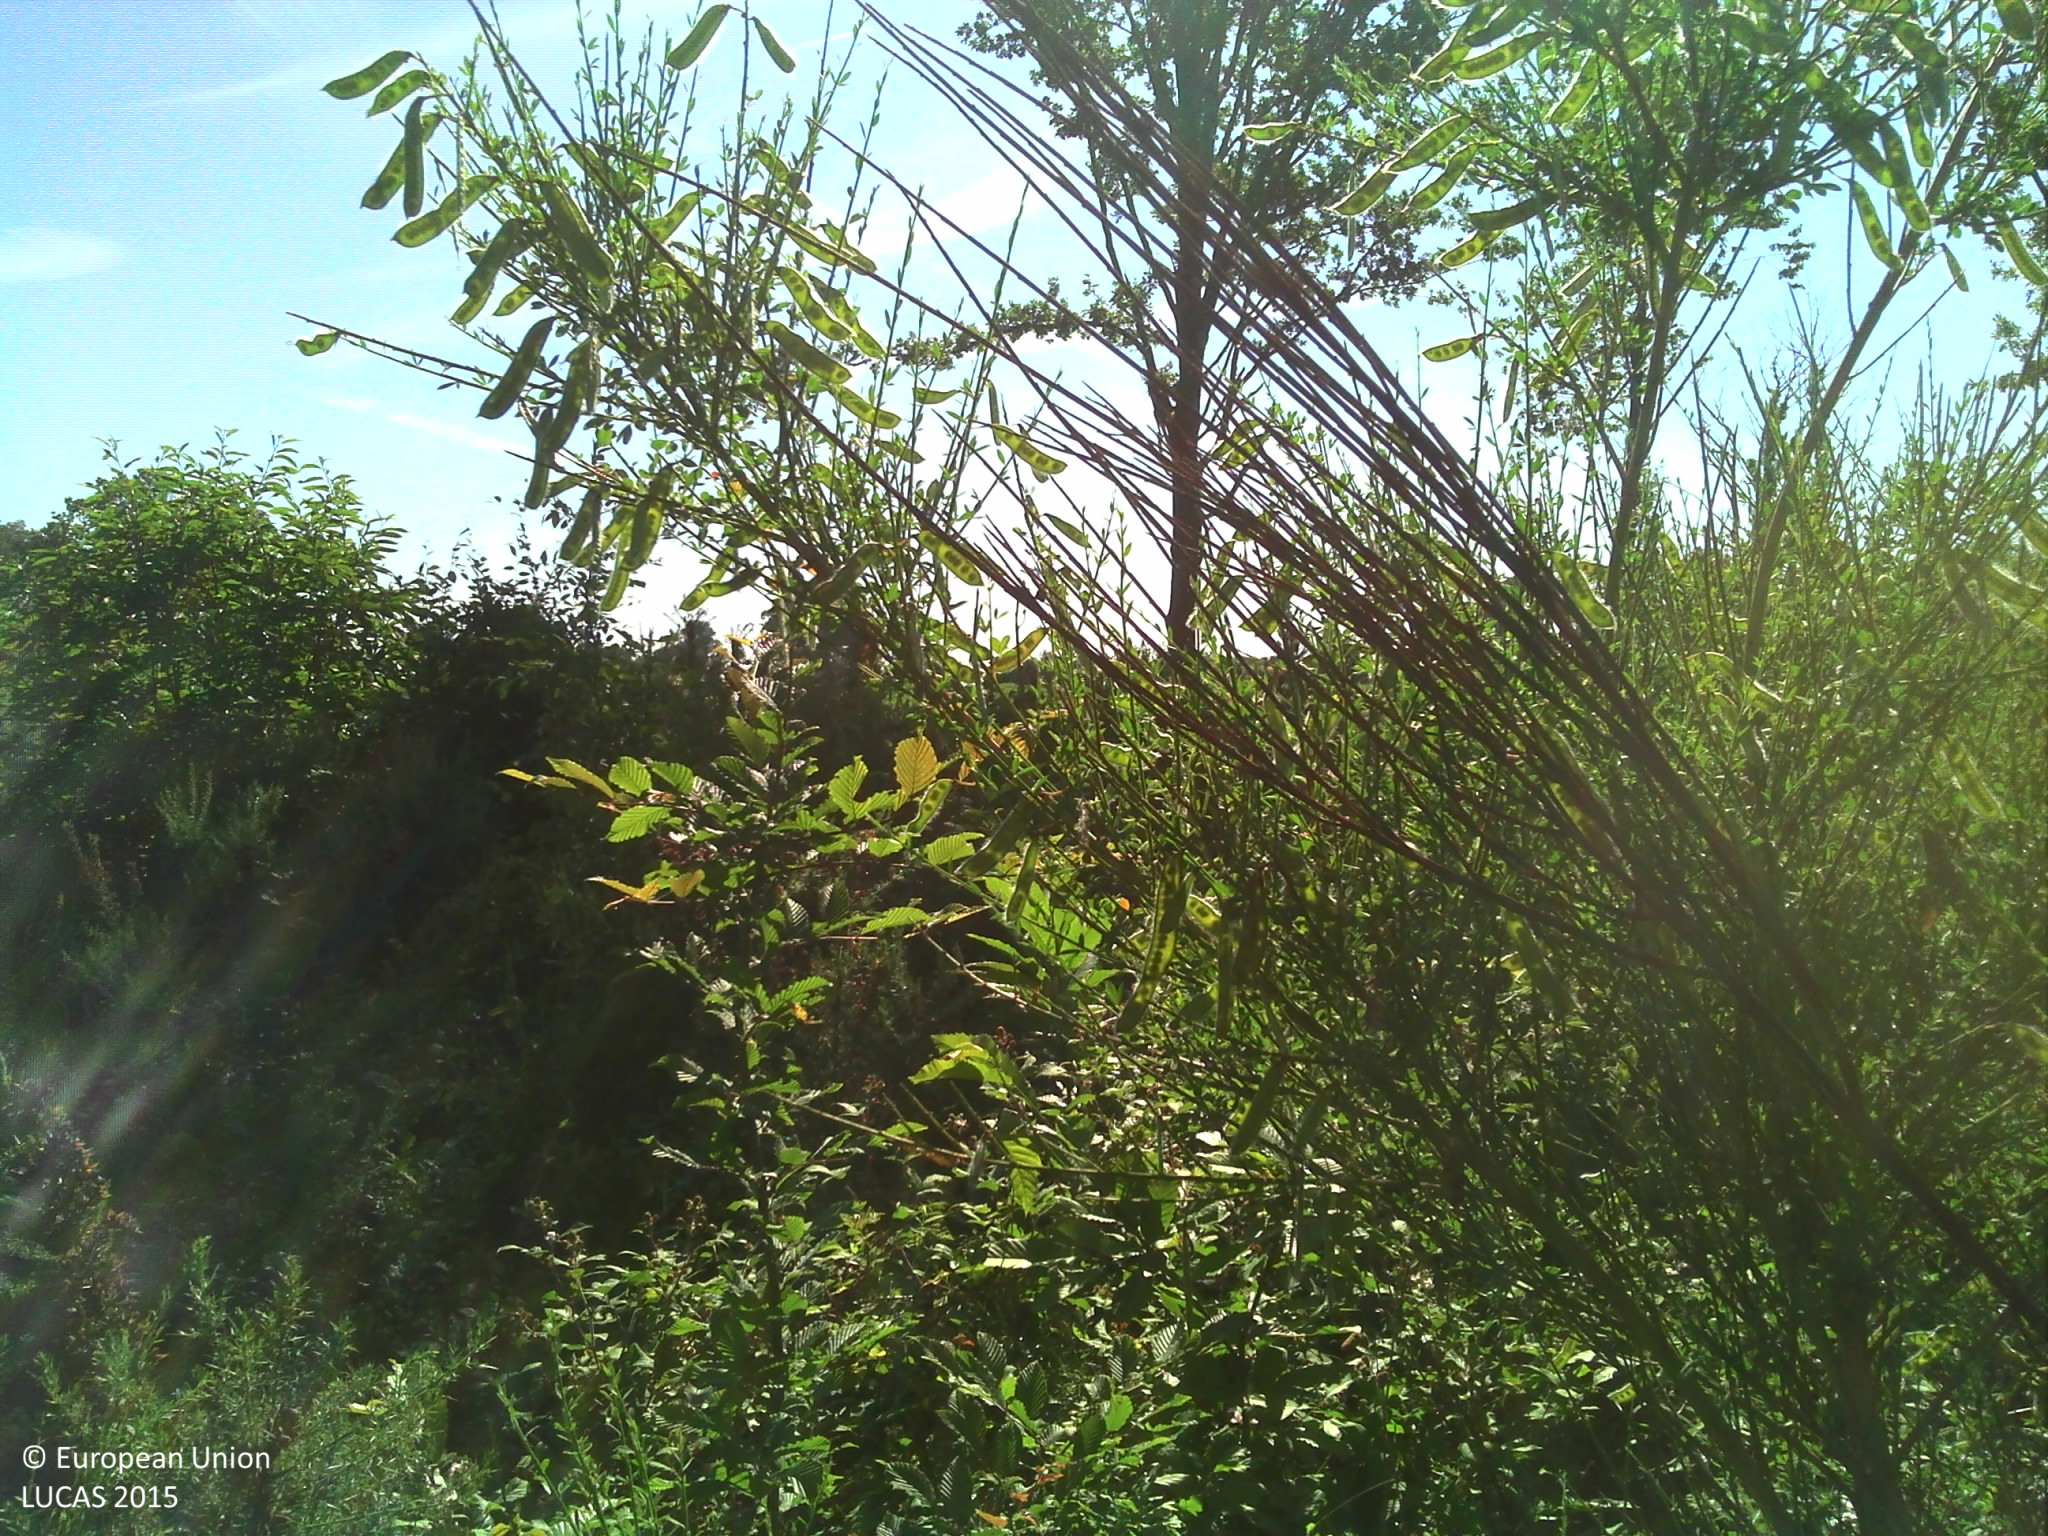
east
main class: Woodland
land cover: Broadleaved woodland
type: thermophilous deciduous forest
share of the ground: > 75 %
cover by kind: shrubs 45 %, broadleaved forest trees 35 %, herbaceous plants 15 %, lichens and mosses 5 %
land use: Semi-natural and natural areas not in use
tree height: > 5 m
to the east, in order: Broadleaved woodland; Fences; Sunflower
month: June
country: FR
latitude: 45.8654
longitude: 0.4139
